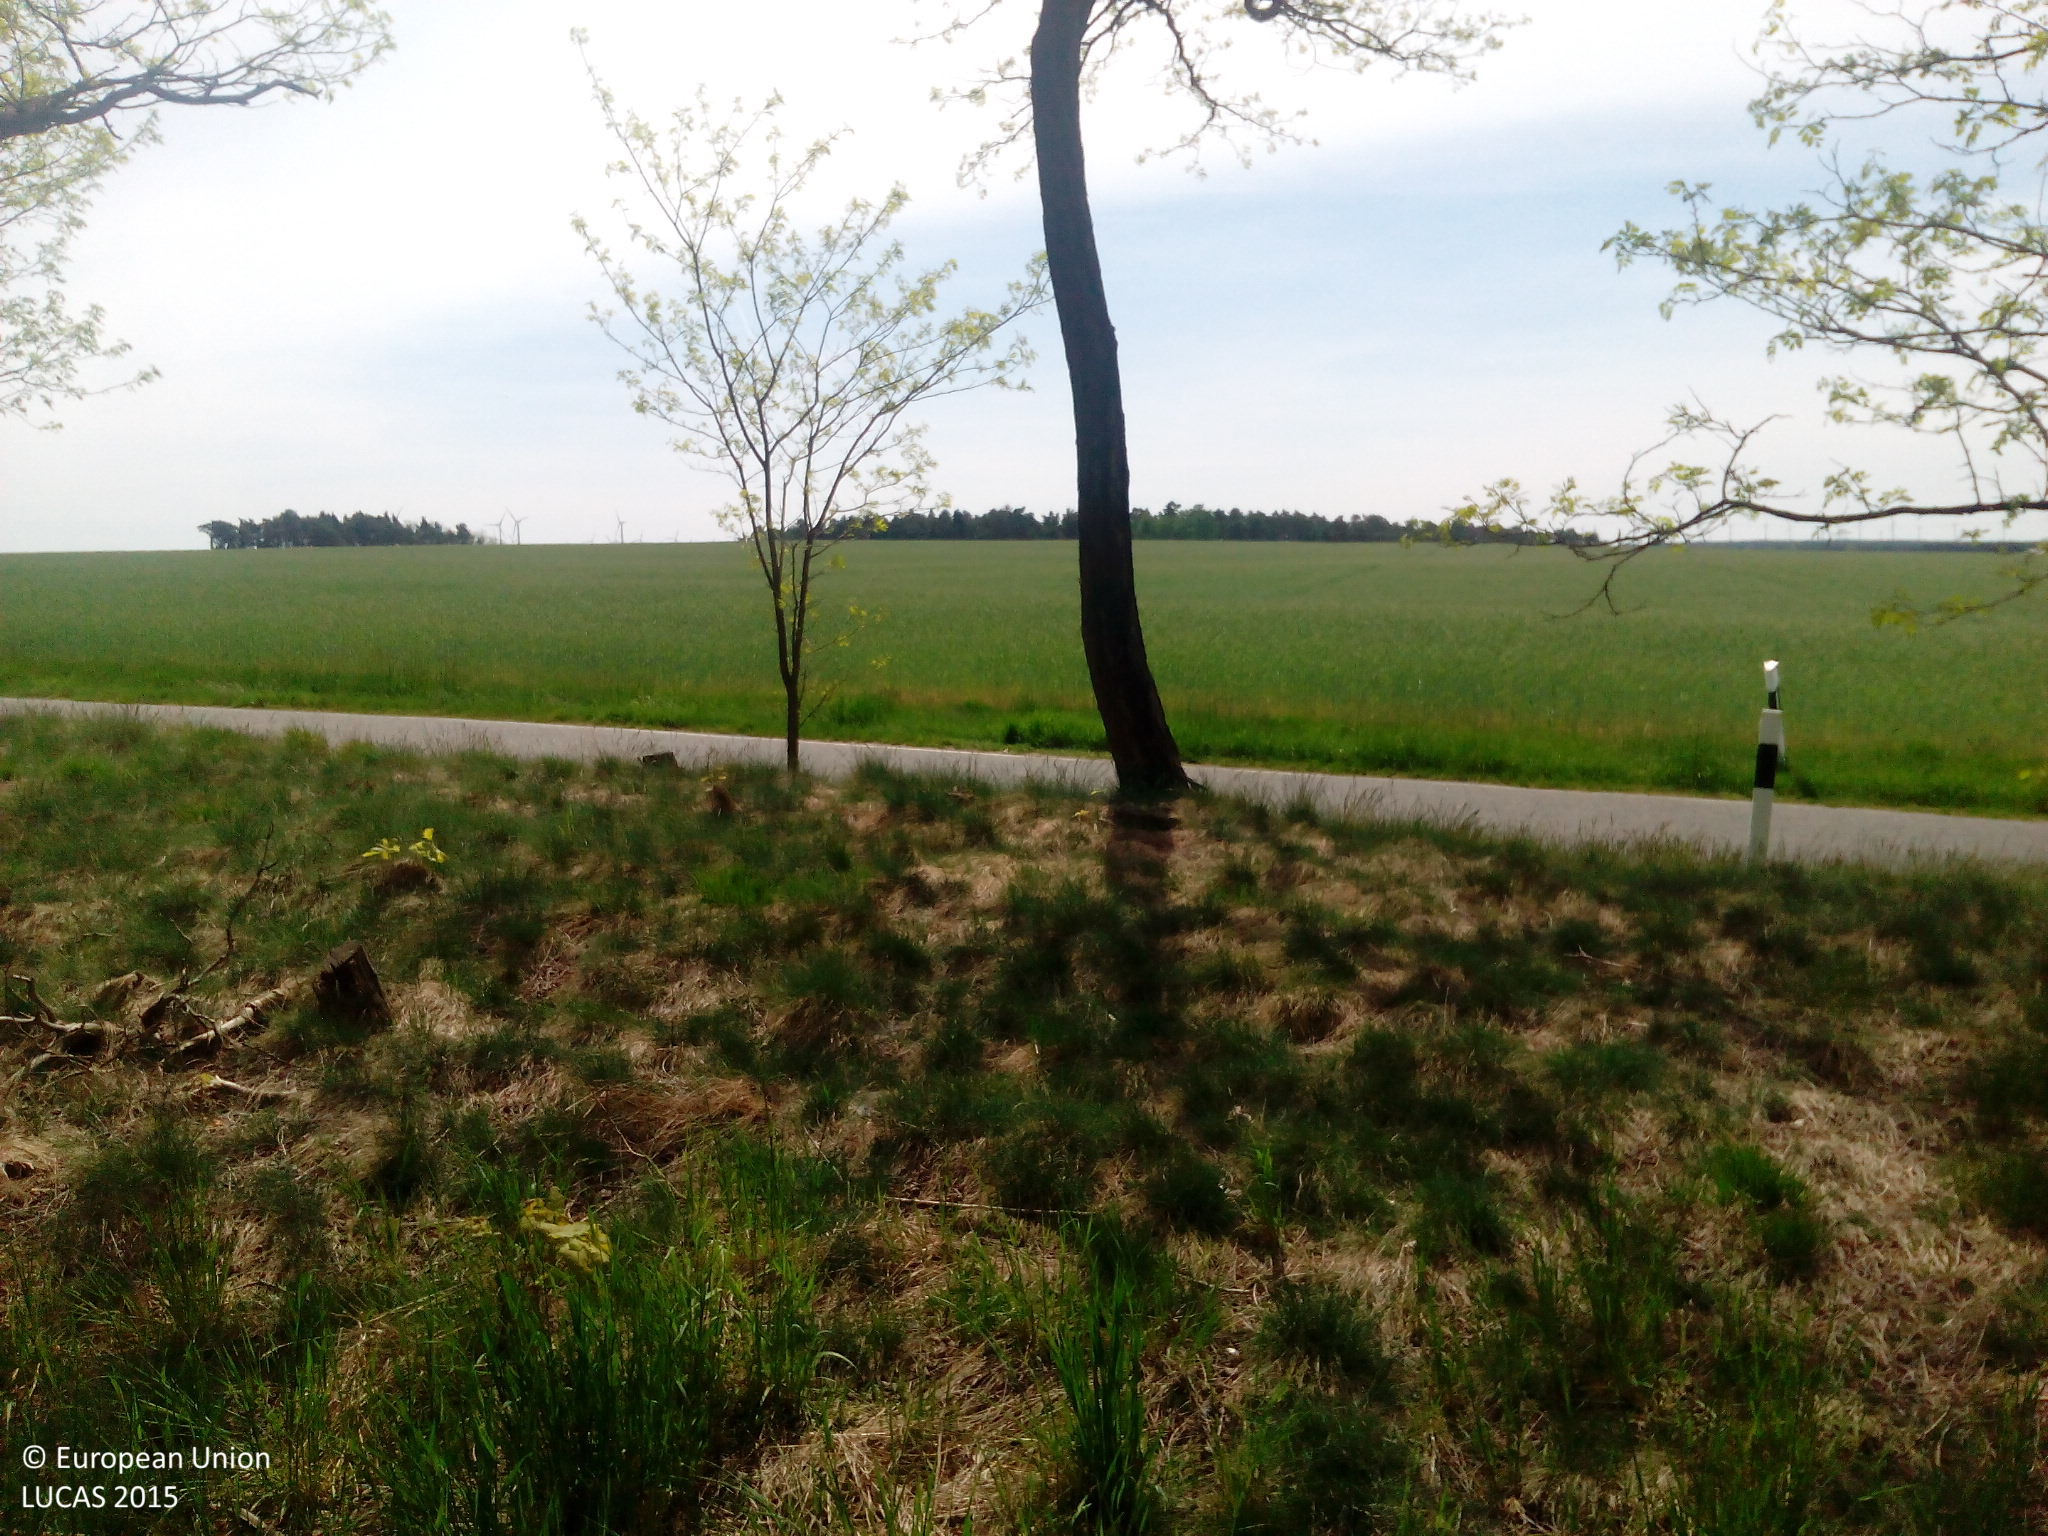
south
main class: Woodland
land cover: Broadleaved woodland
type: mesophytic deciduous forest
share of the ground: > 75 %
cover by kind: broadleaved forest trees 90 %, coniferous forest trees 10 %
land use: Forestry
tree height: > 5 m
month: May
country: DE
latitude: 51.9282
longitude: 13.5633
